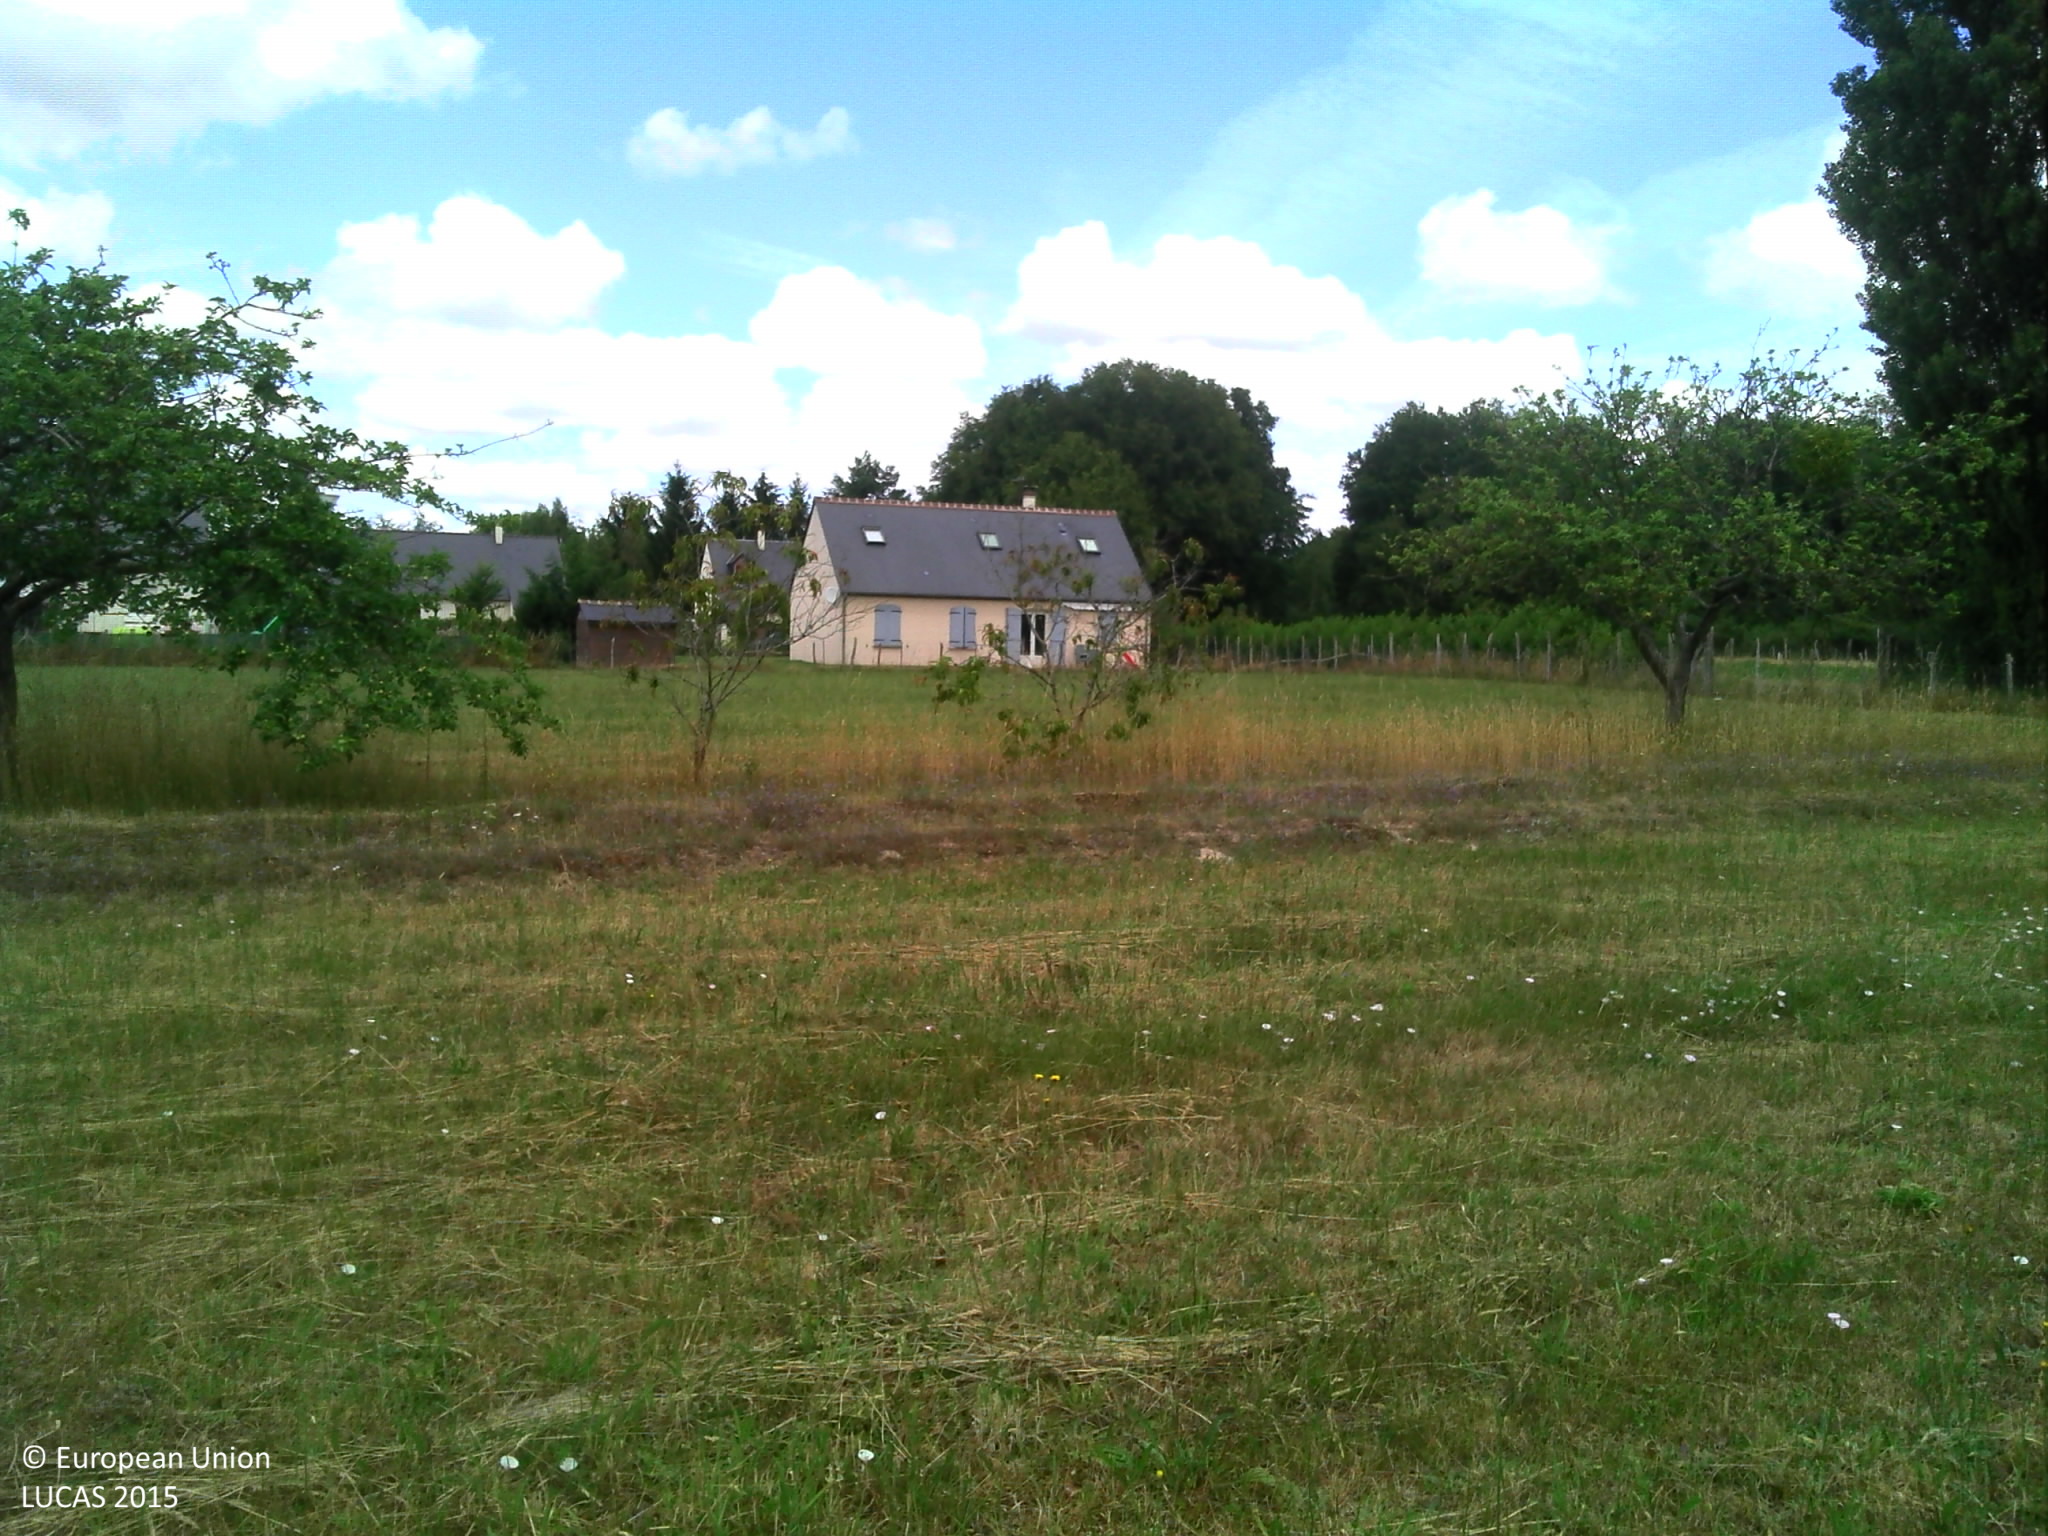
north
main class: Grassland
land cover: Grassland without tree/shrub cover
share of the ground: > 75 %
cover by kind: herbaceous plants 100 %
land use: Agriculture (excluding fallow land and kitchen gardens)
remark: Harvested field
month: June
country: FR
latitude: 47.4226
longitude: 0.3940
